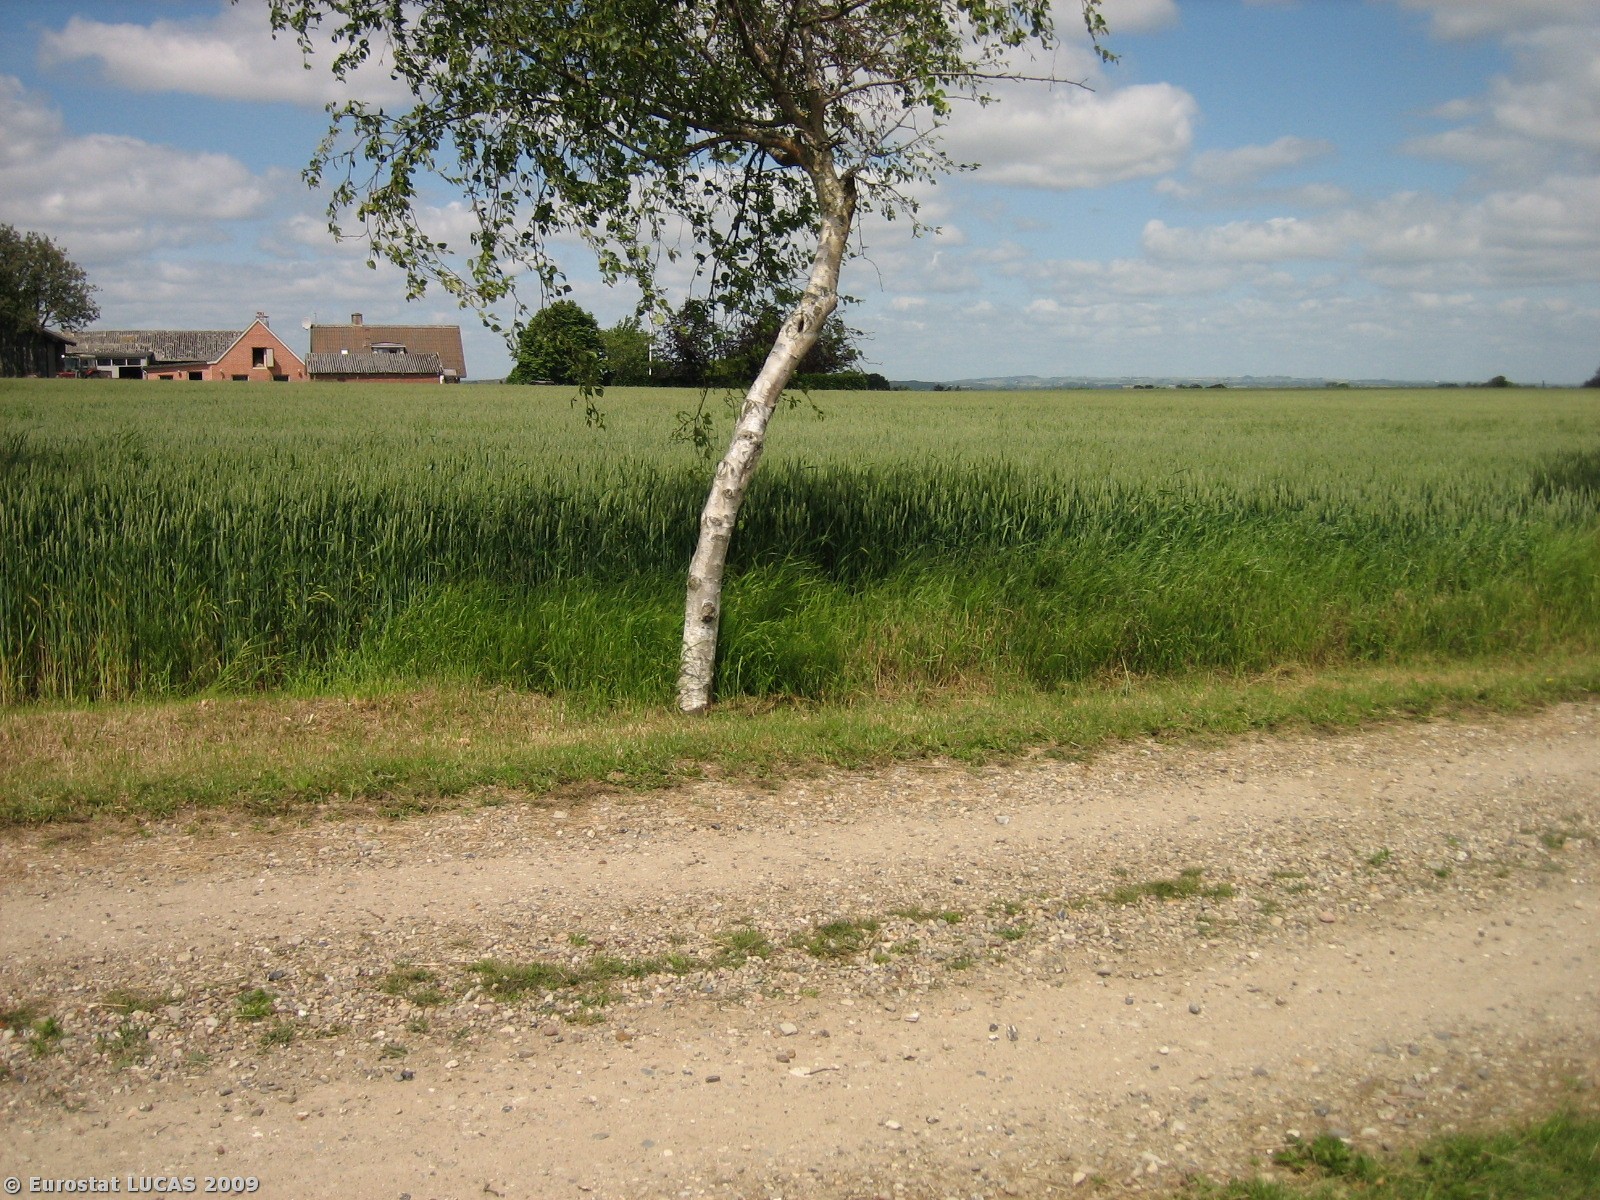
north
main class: Artificial land
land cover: Non built-up linear features
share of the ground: > 75 %
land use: Residential
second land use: Road transport
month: June
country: DK
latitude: 55.8279
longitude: 9.7289
